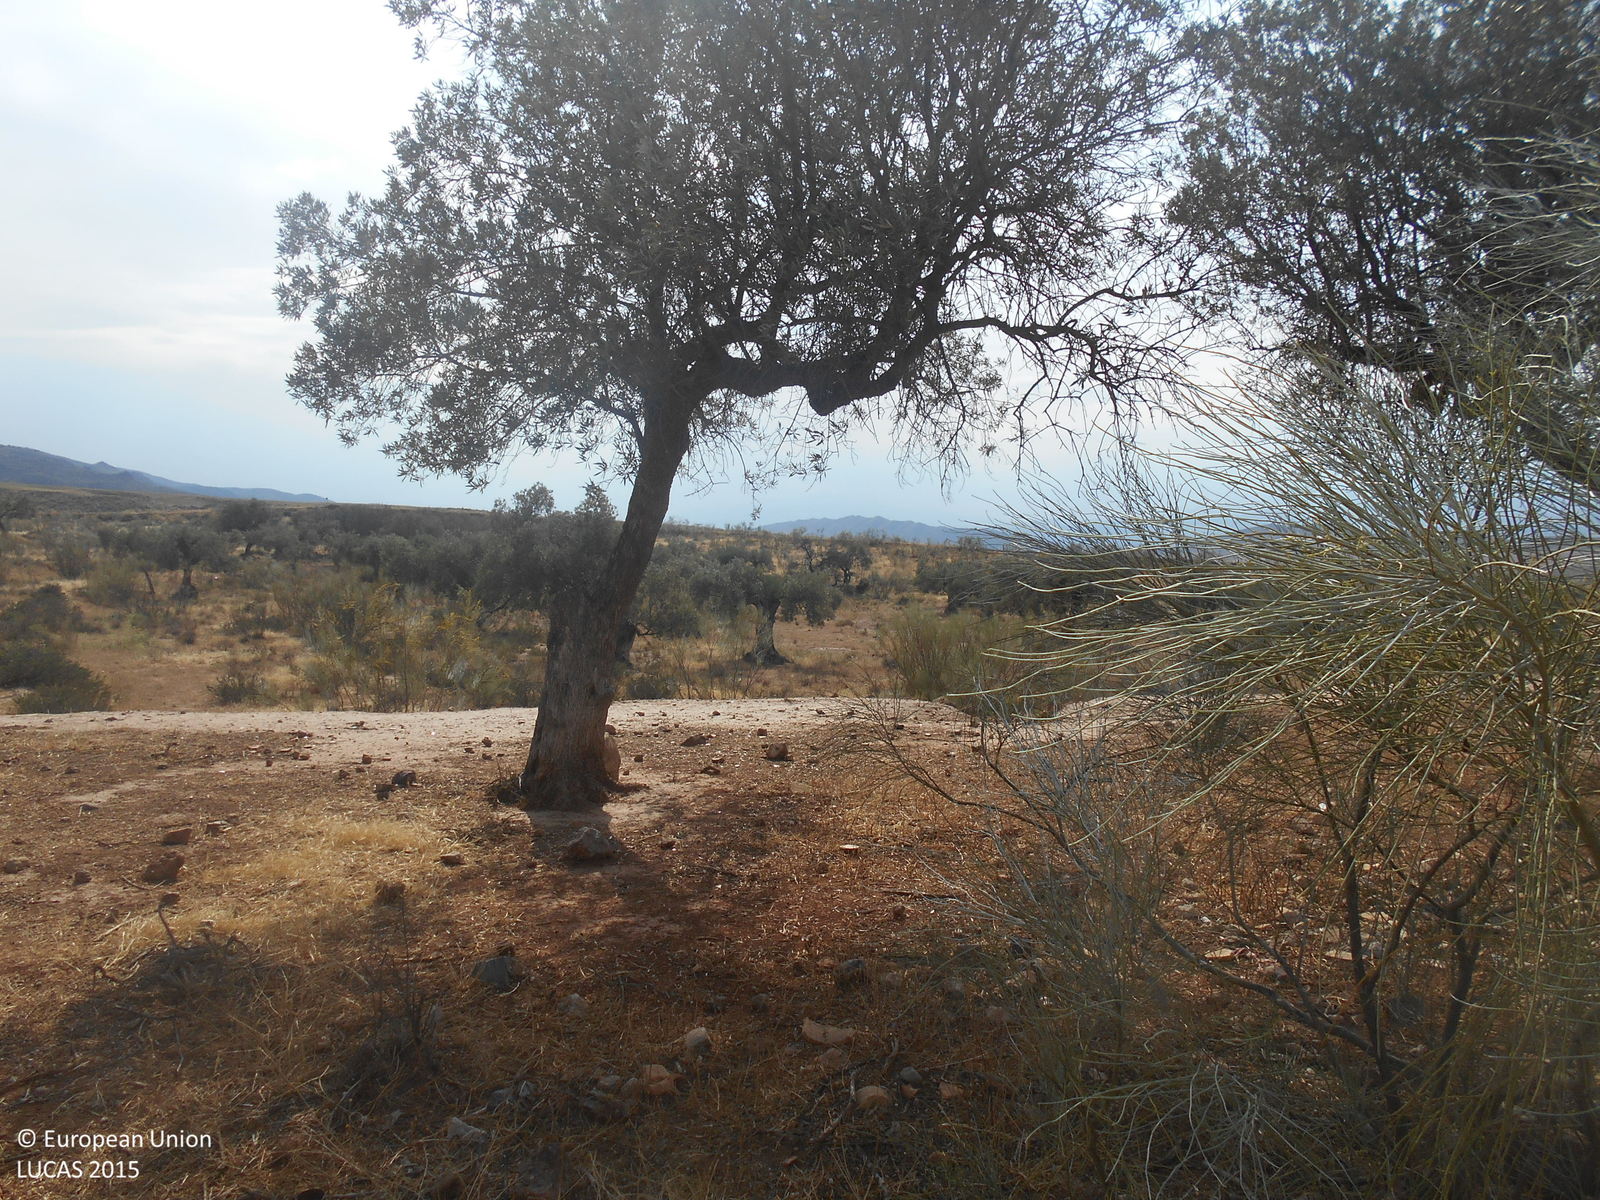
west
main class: Shrubland
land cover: Shrubland with sparse tree cover
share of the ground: 10 - 25 %
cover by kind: herbaceous plants 40 %, unconsolidated bare surface 35 %, shrubs 20 %, broadleaved forest trees 5 %
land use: Semi-natural and natural areas not in use
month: May
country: ES
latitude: 37.0448
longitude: -2.2437
